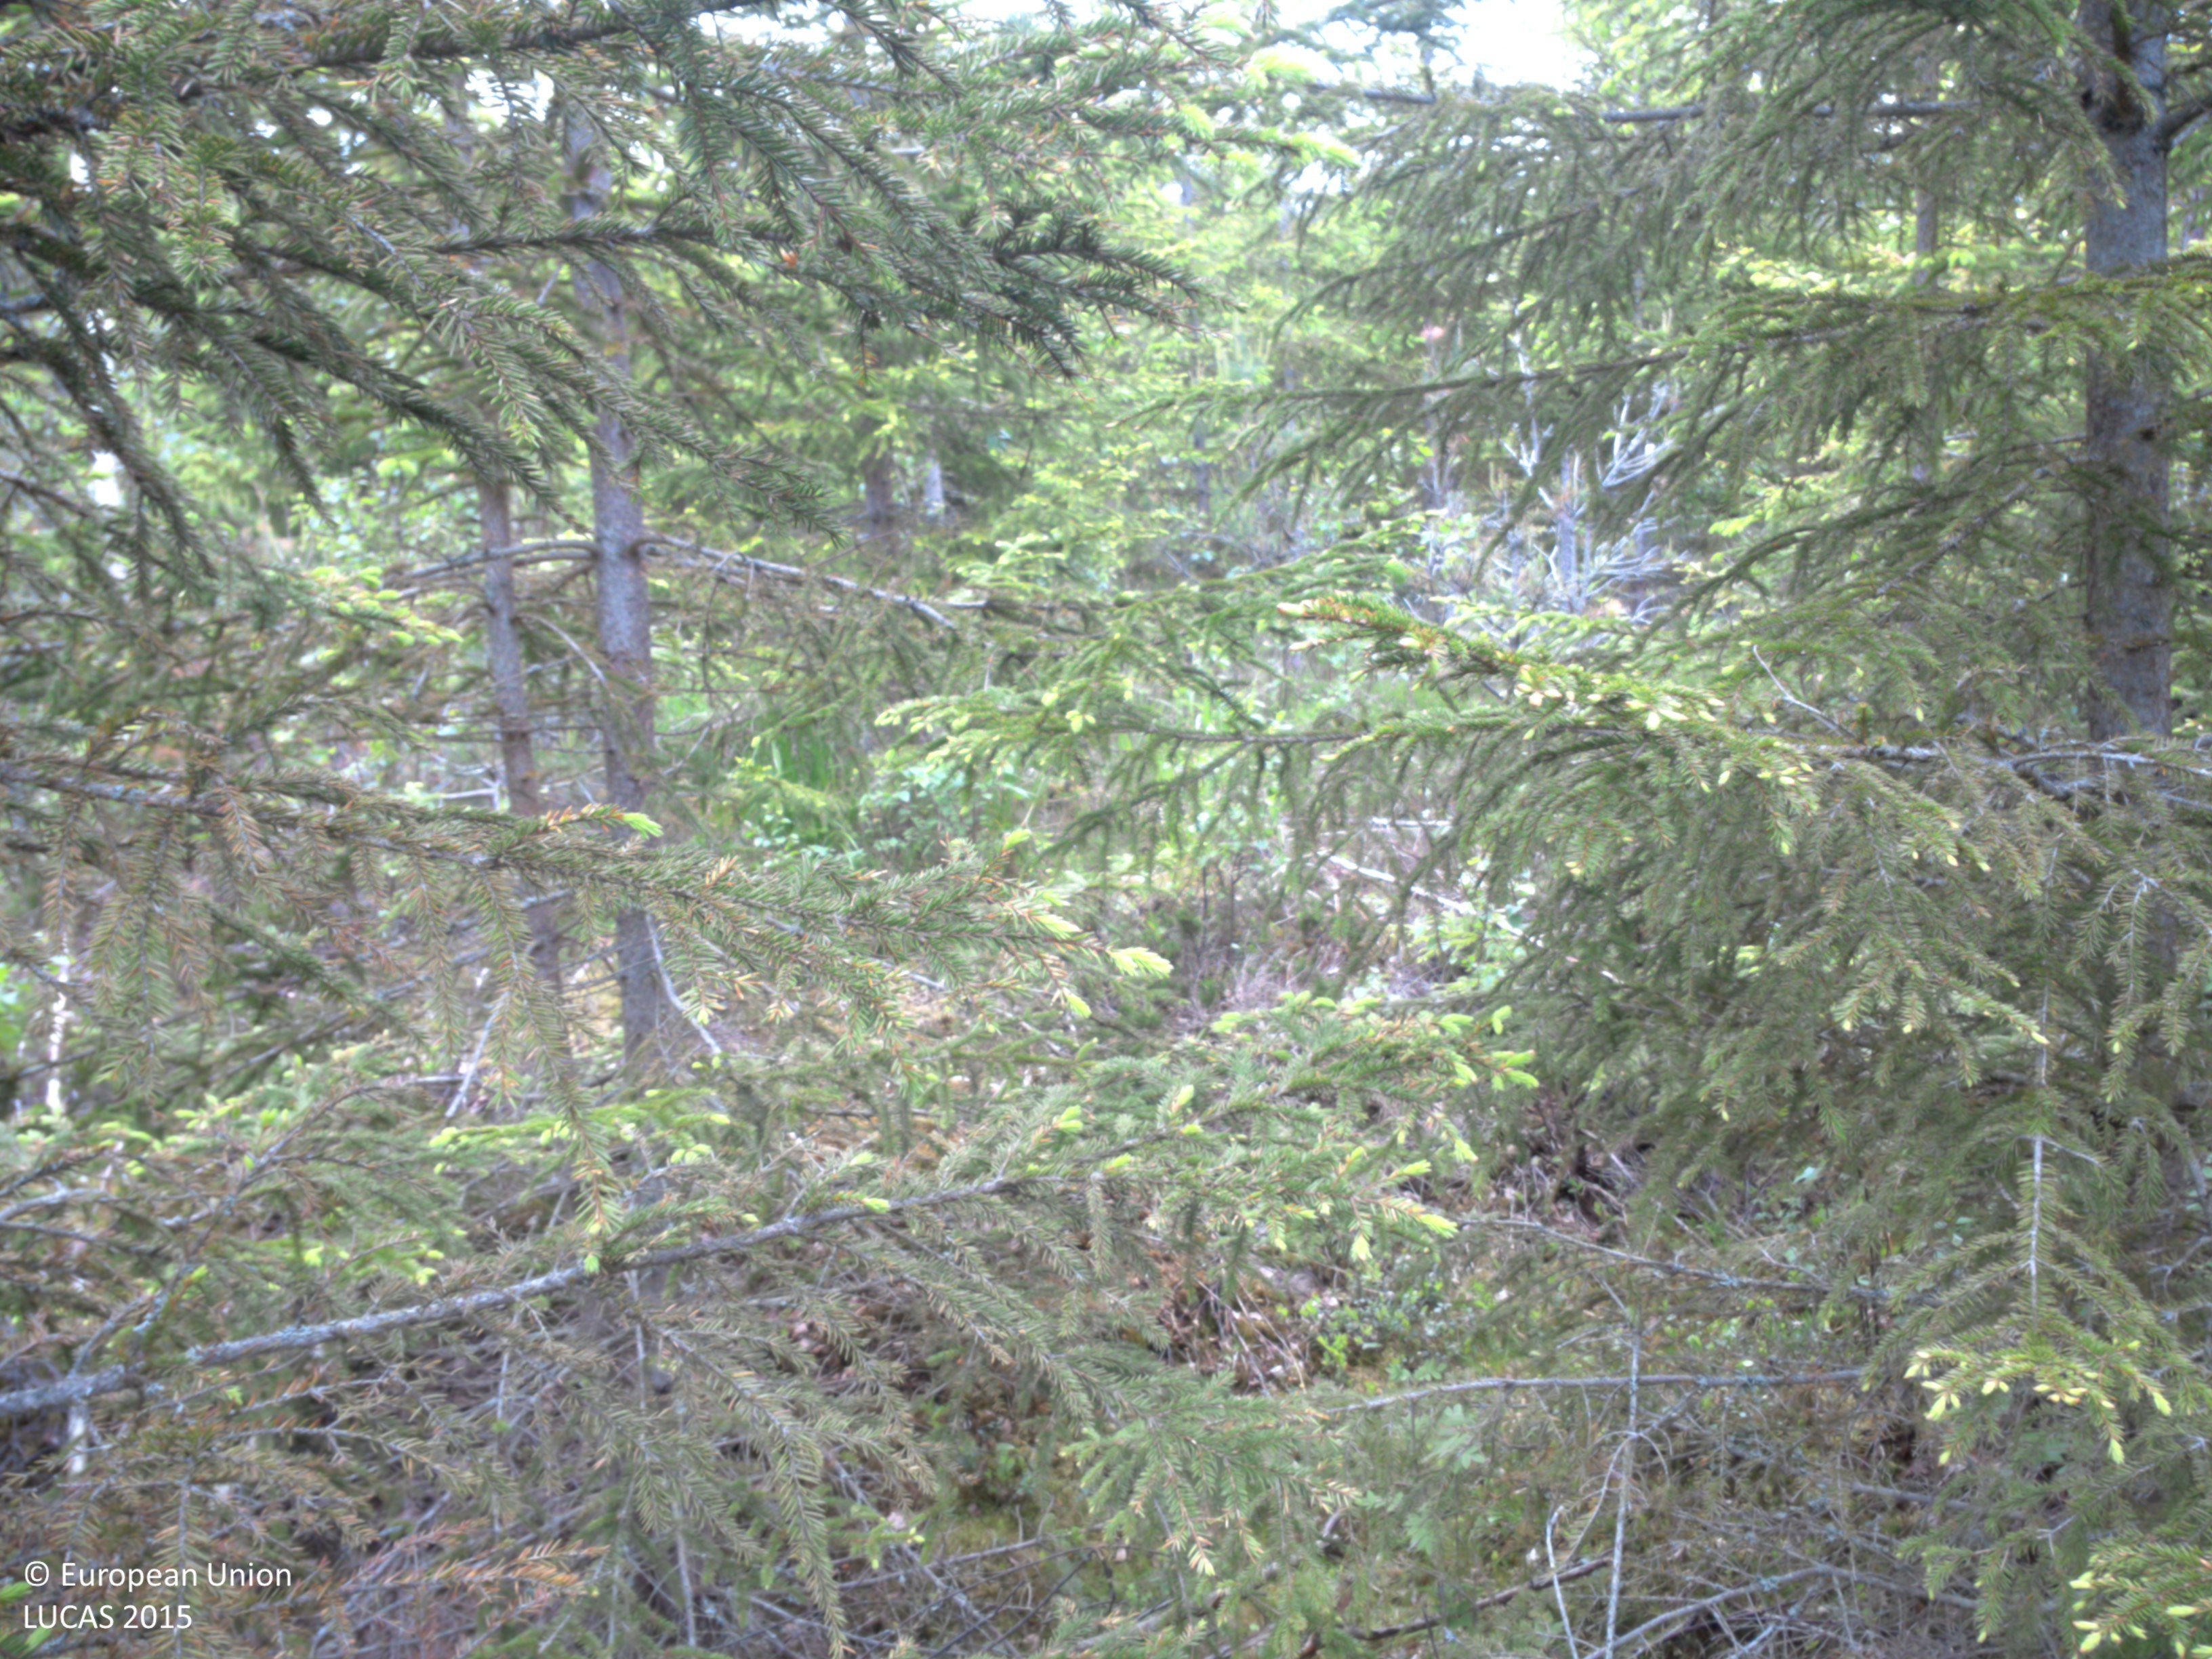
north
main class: Woodland
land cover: Spruce dominated mixed woodland
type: boreal forest
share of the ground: 50 - 75 %
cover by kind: coniferous forest trees 45 %, broadleaved forest trees 25 %, herbaceous plants 20 %, shrubs 10 %
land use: Forestry
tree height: > 5 m
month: June
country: SE
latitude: 59.1587
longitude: 11.9713
